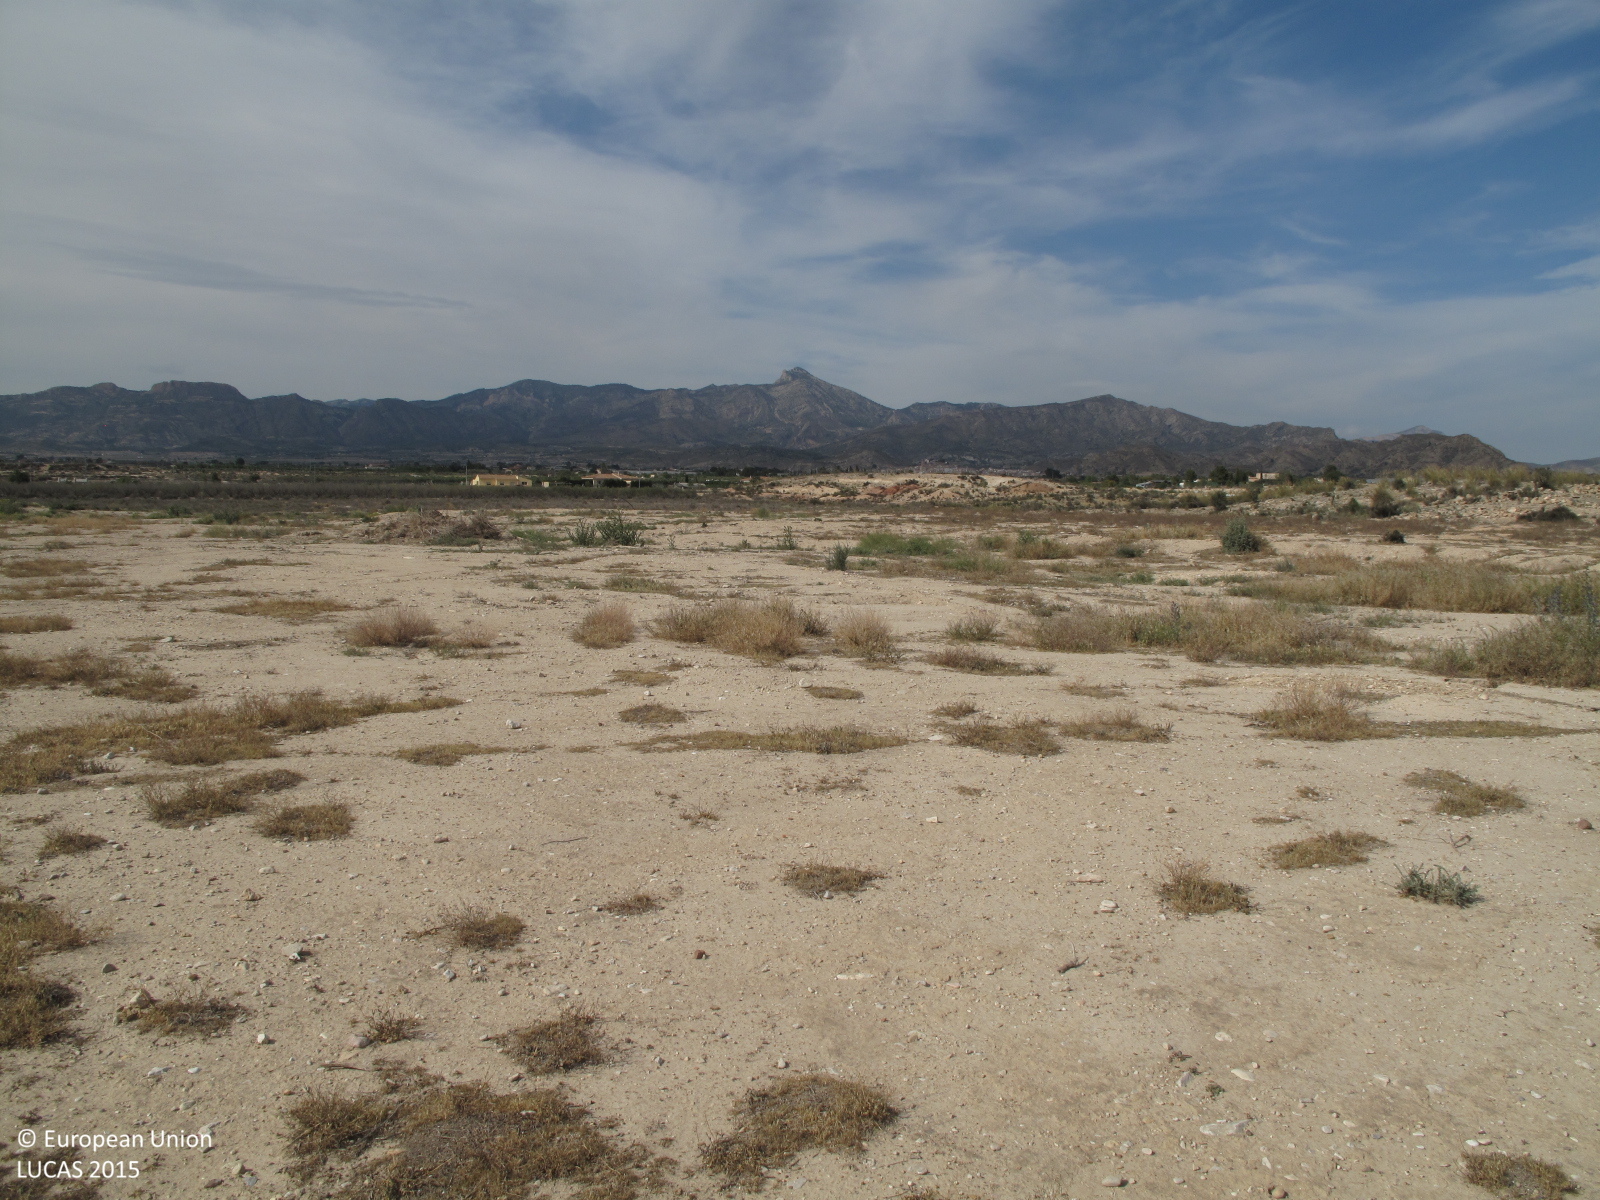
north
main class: Grassland
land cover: Grassland without tree/shrub cover
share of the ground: 10 - 25 %
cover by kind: consolidated bare surface 80 %, herbaceous plants 20 %
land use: Semi-natural and natural areas not in use
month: April
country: ES
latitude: 38.4087
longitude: -0.6485
